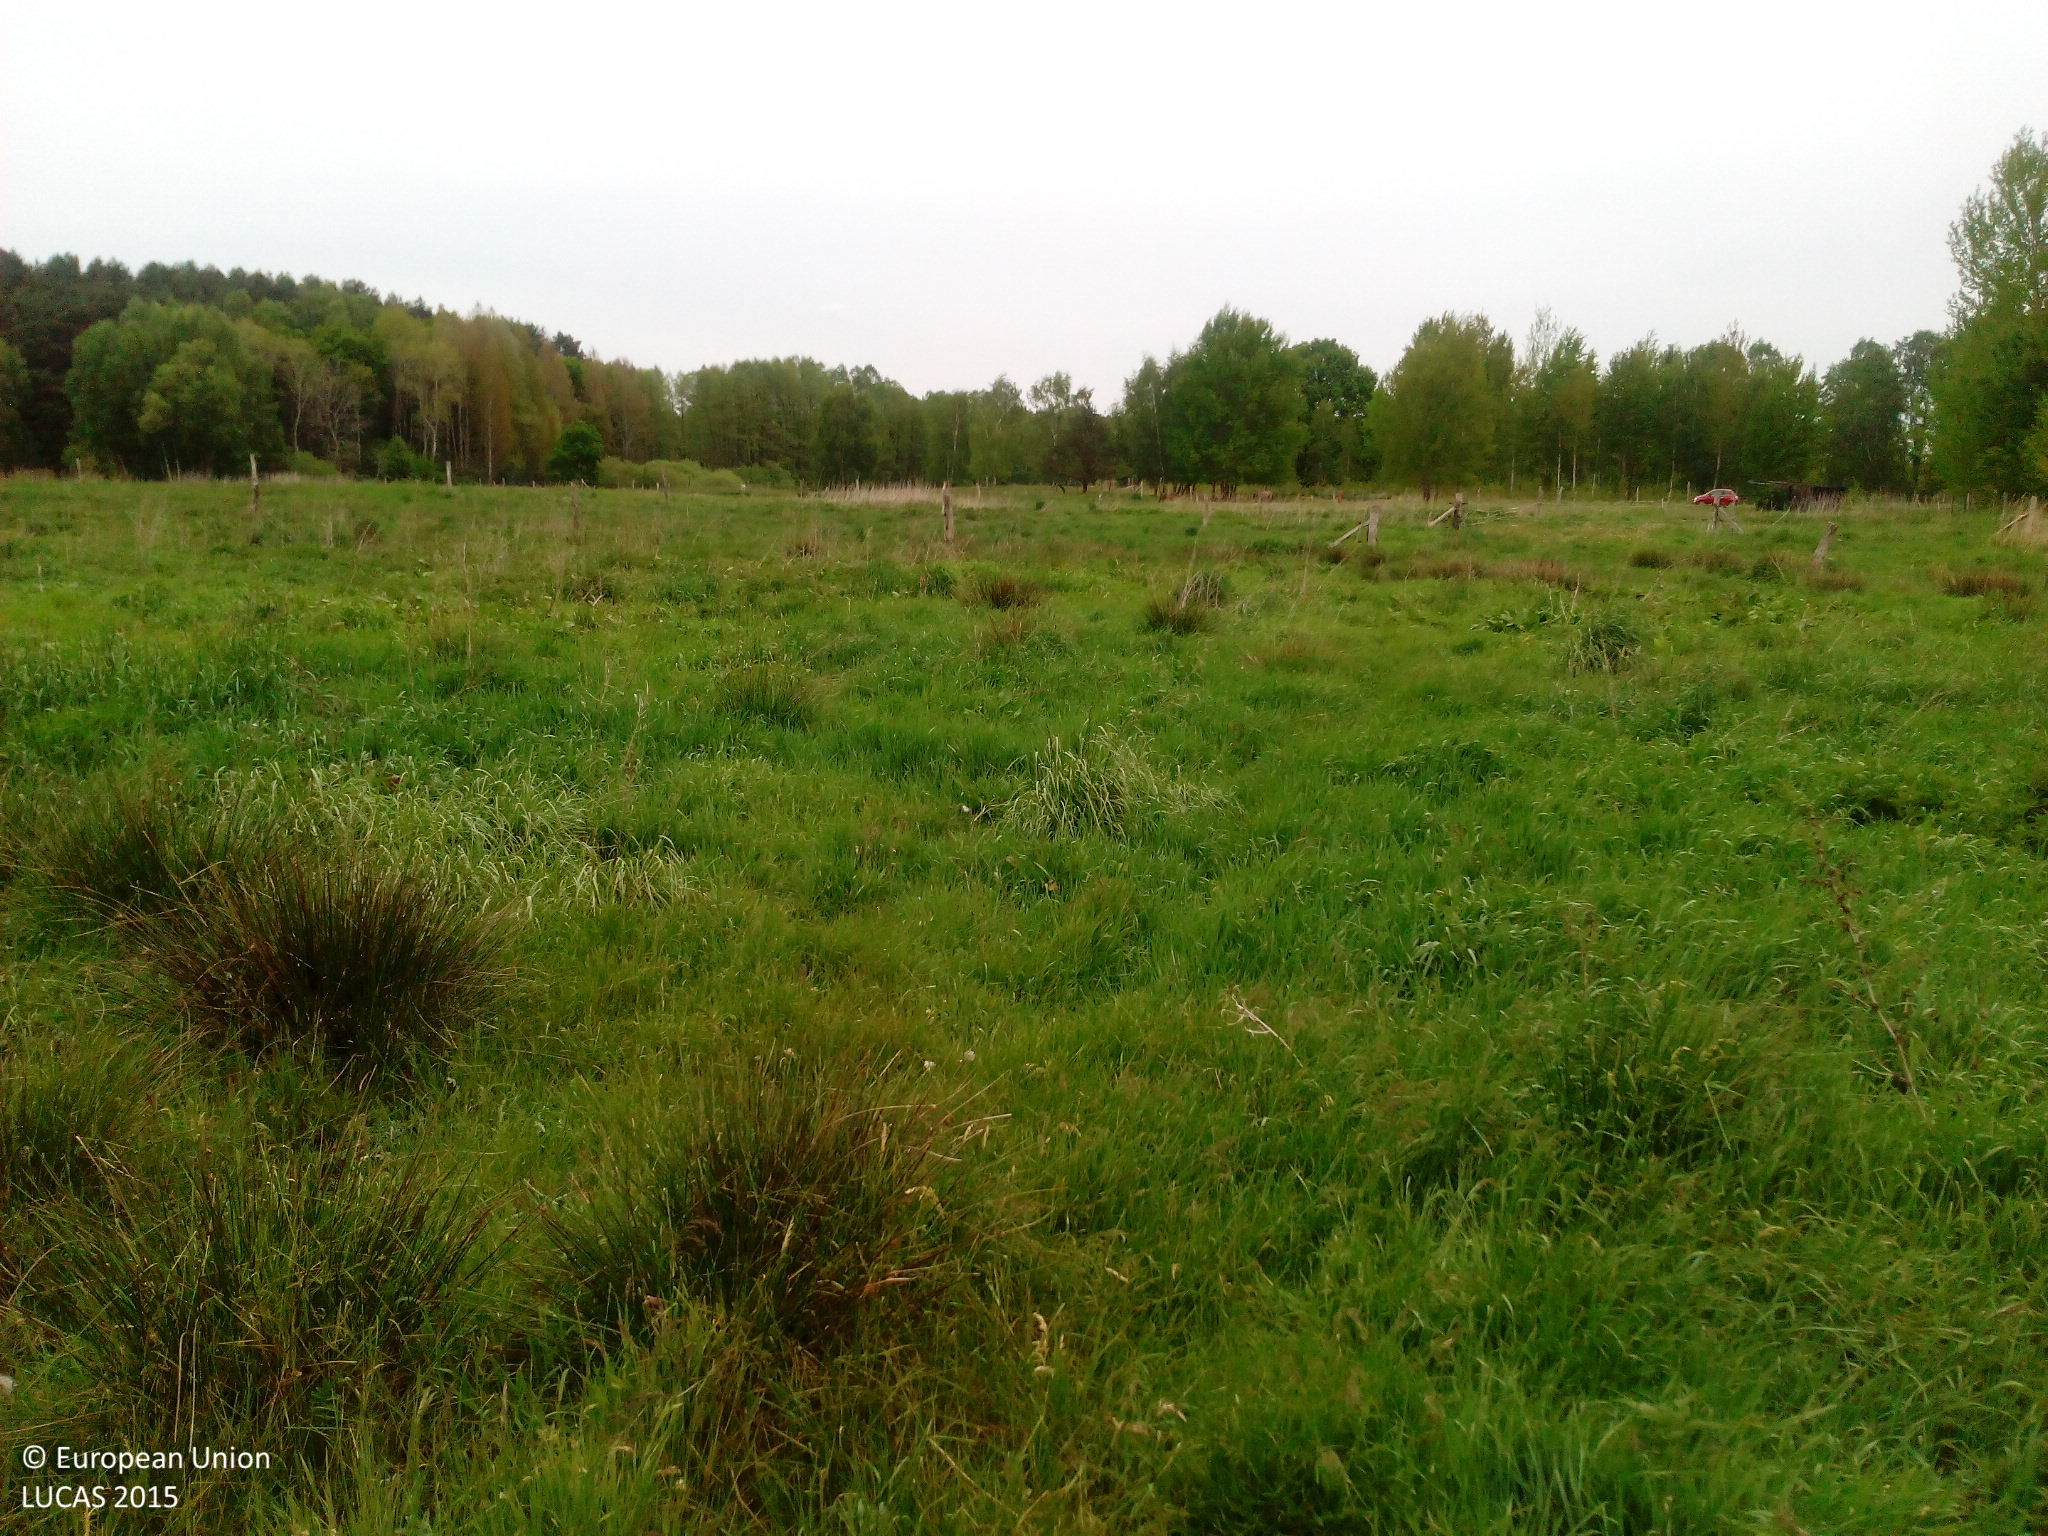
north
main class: Grassland
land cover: Grassland without tree/shrub cover
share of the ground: > 75 %
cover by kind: herbaceous plants 100 %
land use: Agriculture (excluding fallow land and kitchen gardens)
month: May
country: DE
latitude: 52.1583
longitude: 13.0550
